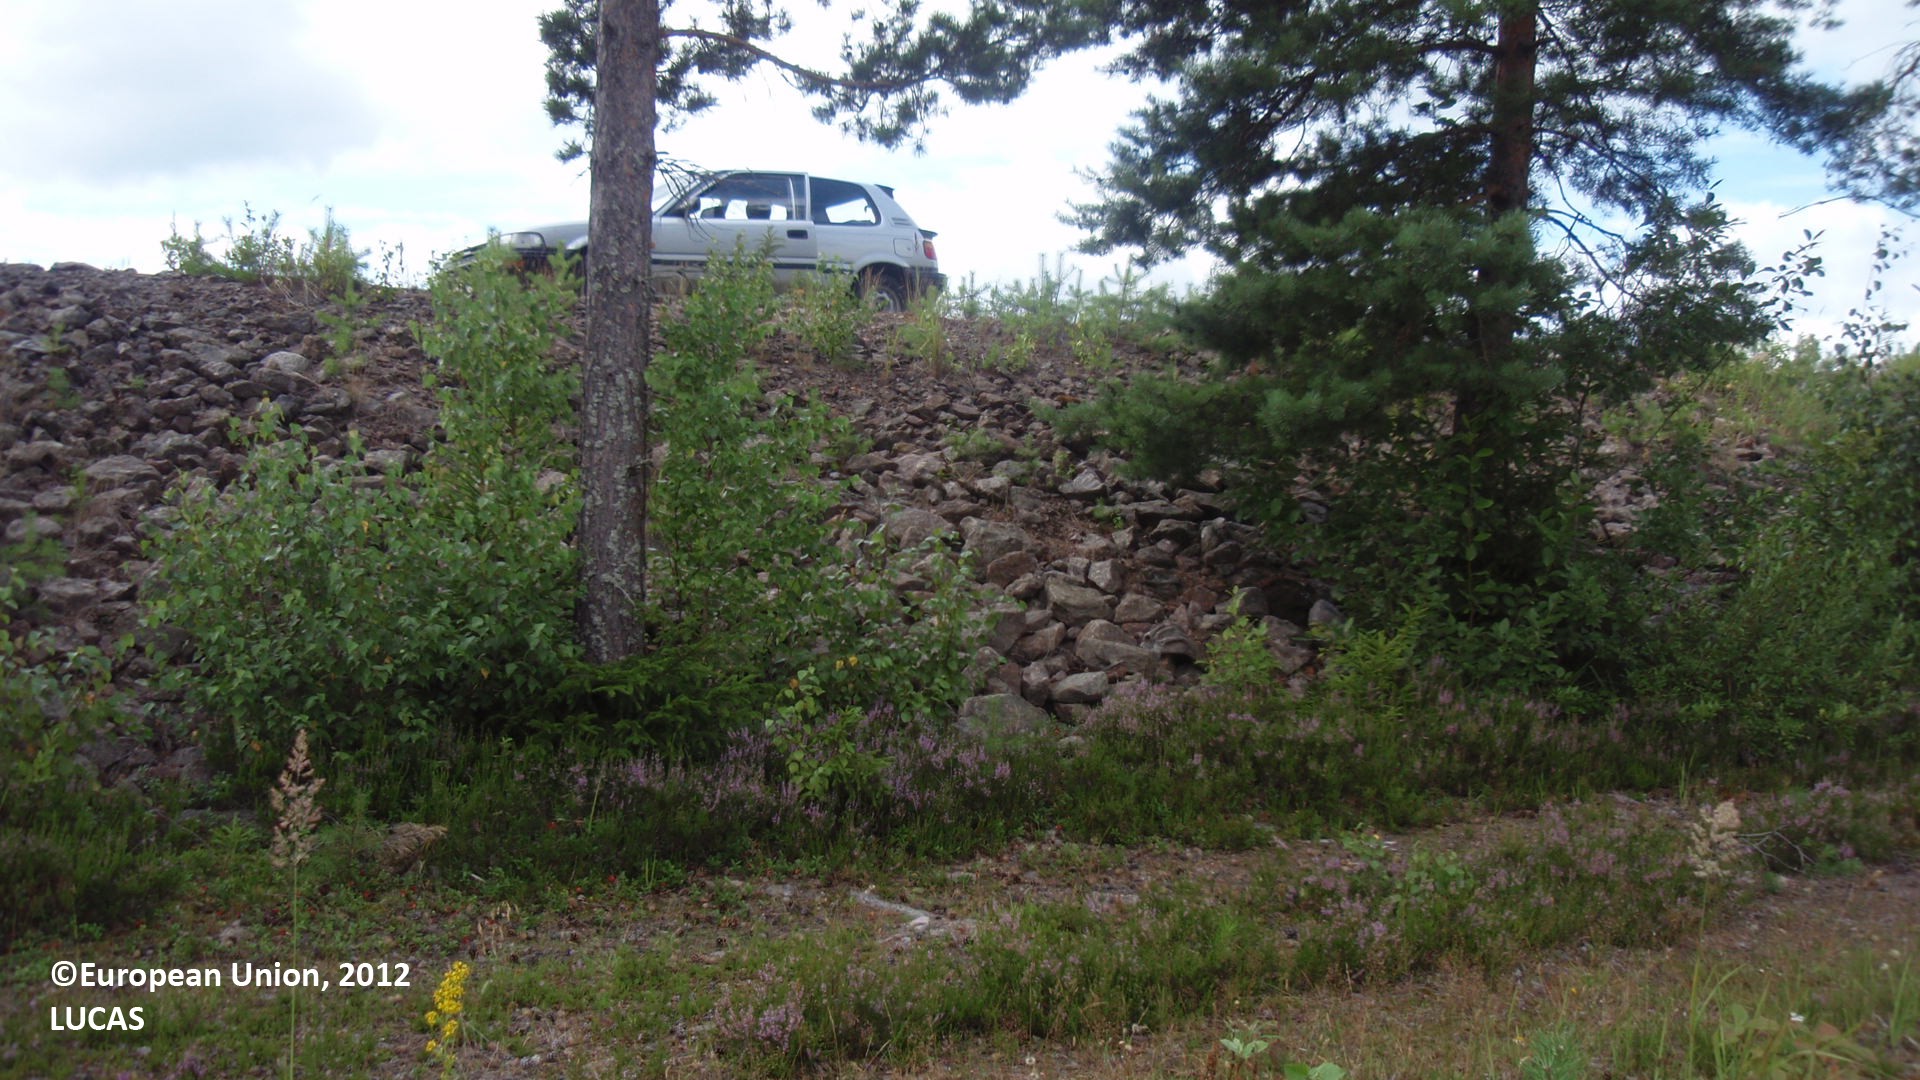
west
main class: Cropland
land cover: Oats
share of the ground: > 75 %
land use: Agriculture (excluding fallow land and kitchen gardens)
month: July
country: FI
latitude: 61.0059
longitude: 28.4694
